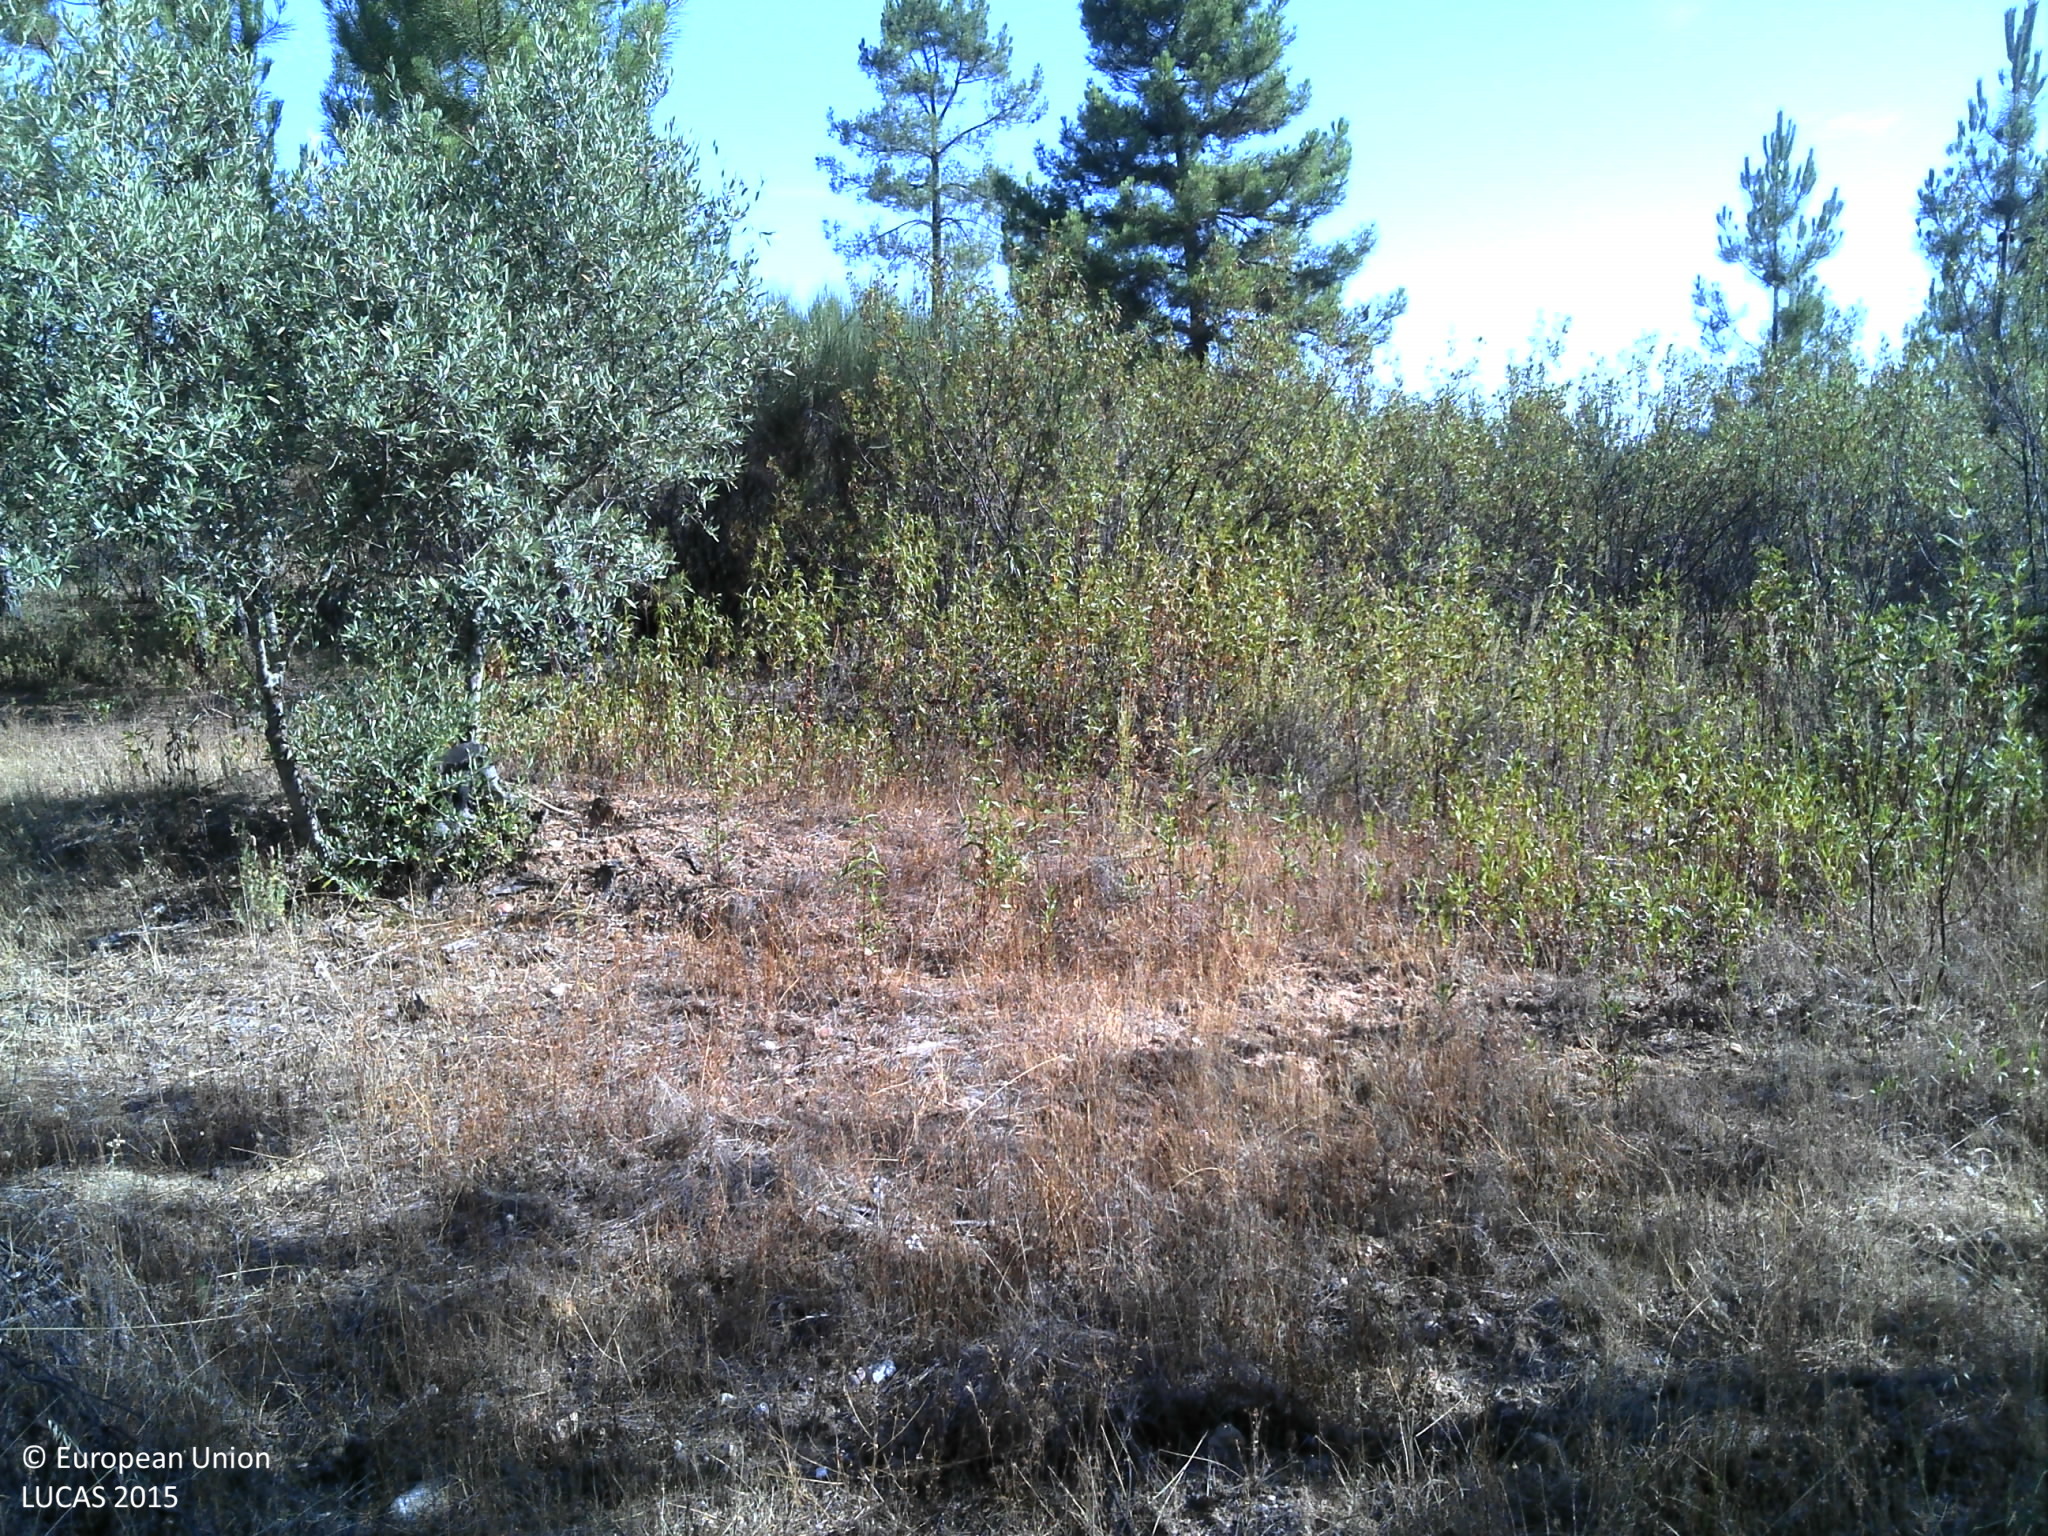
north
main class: Woodland
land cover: Pine dominated coniferous woodland
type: coniferous forest of the mediterranean region
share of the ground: 25 - 50 %
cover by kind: coniferous forest trees 30 %, shrubs 30 %, unconsolidated bare surface 30 %, herbaceous plants 10 %
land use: Forestry
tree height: > 5 m
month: July
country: PT
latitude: 39.5228
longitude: -7.9376
